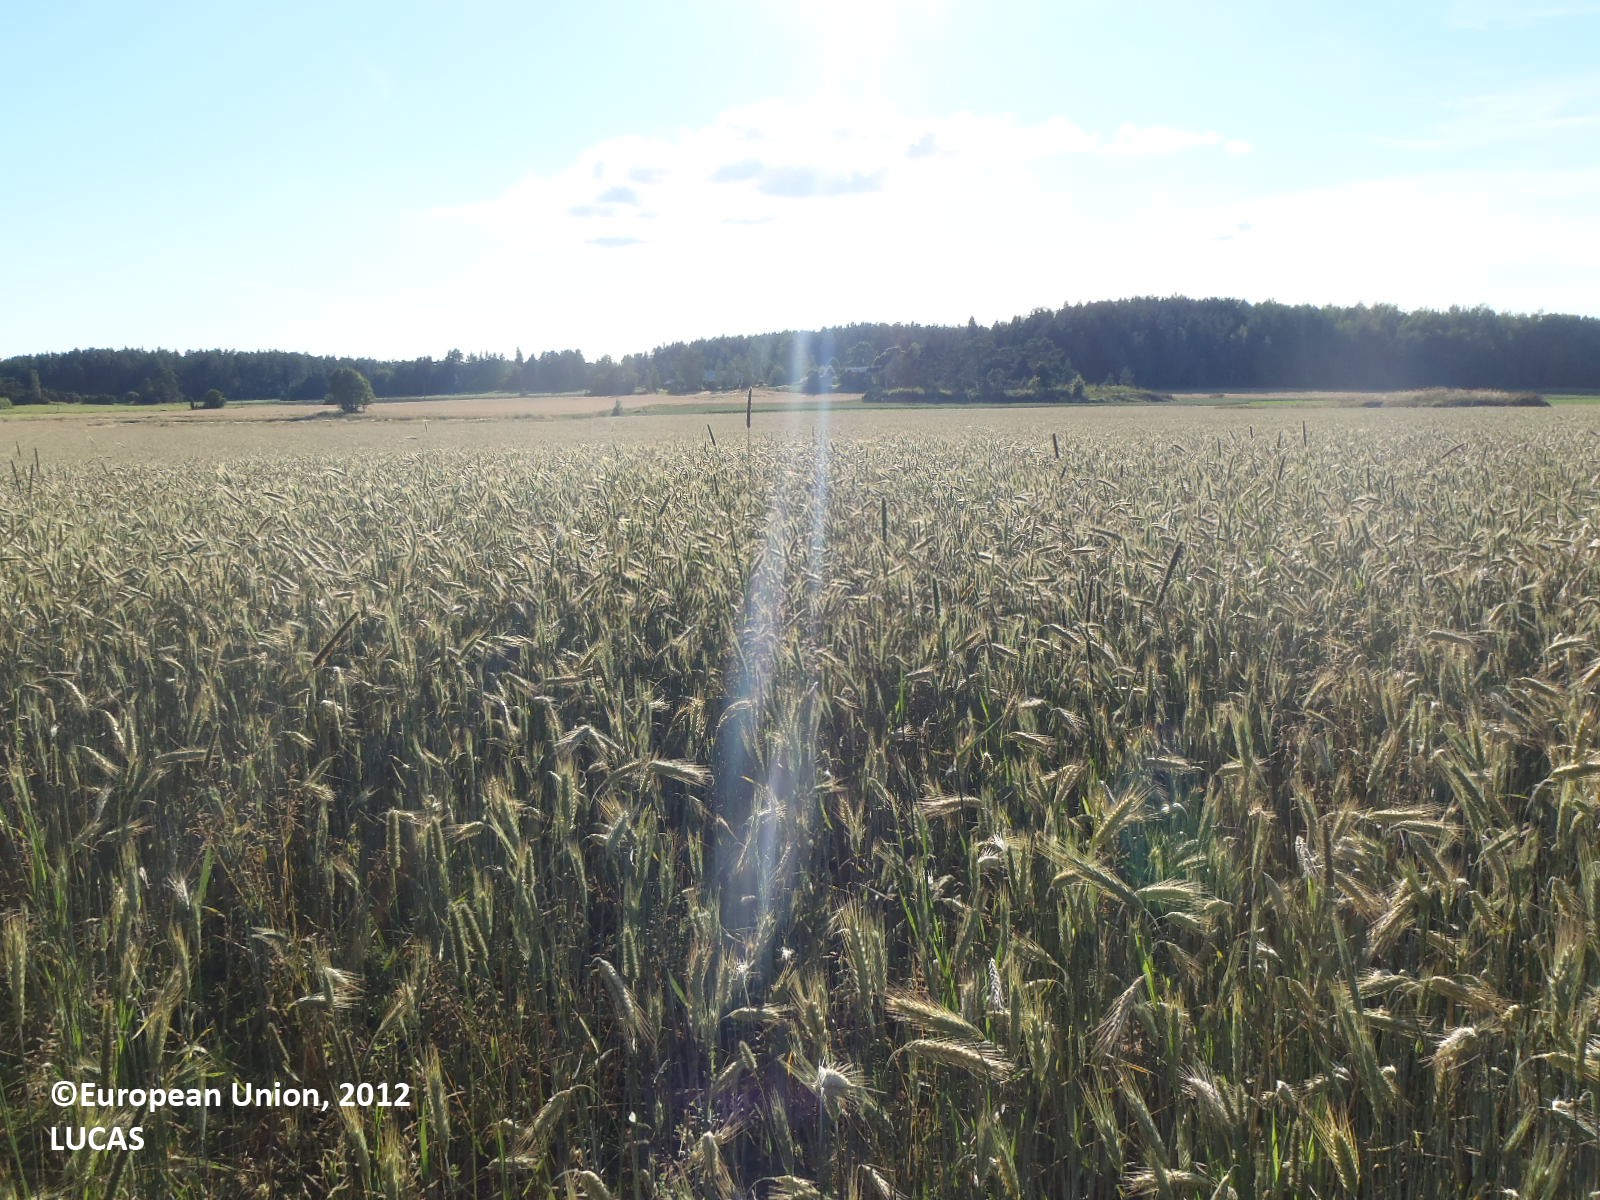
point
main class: Cropland
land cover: Mixed cereals for fodder
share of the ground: > 75 %
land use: Agriculture (excluding fallow land and kitchen gardens)
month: July
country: FI
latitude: 60.6038
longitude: 21.9146
